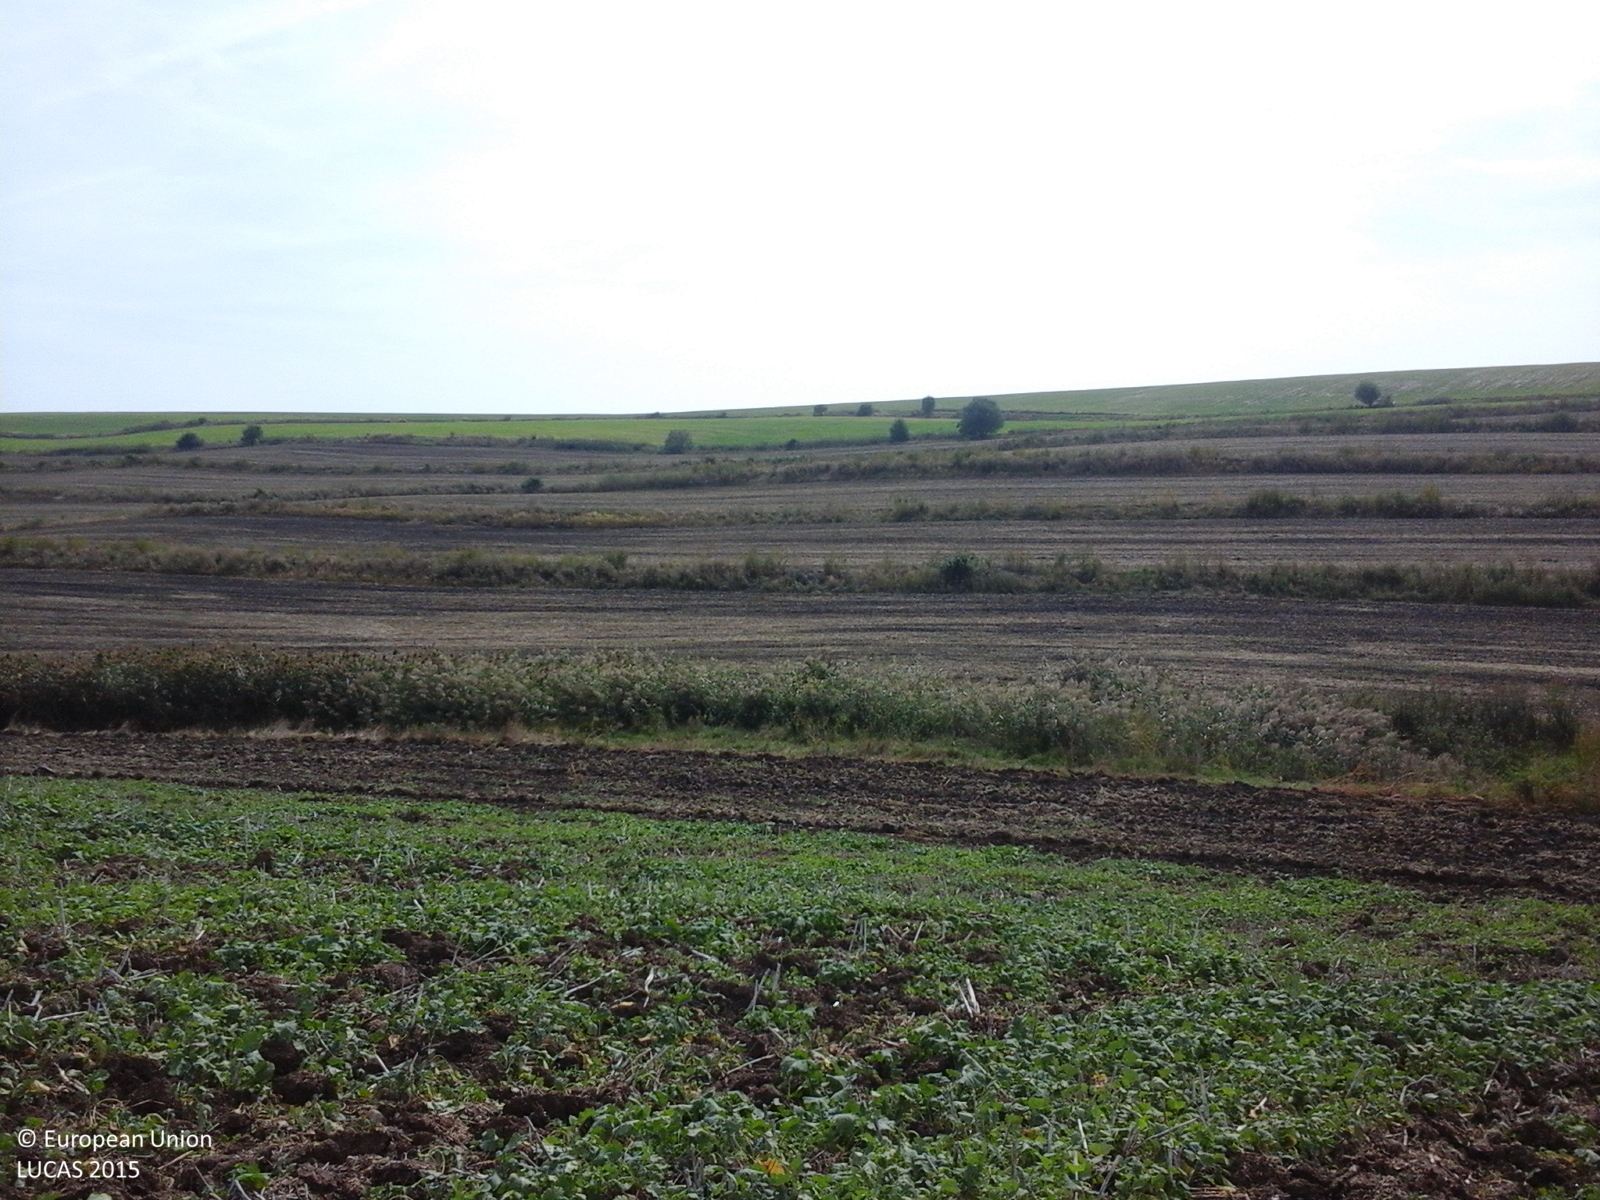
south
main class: Cropland
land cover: Rape and turnip rape
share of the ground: 25 - 50 %
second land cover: Spontaneously vegetated surfaces
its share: 50 - 75 %
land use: Agriculture (excluding fallow land and kitchen gardens)
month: September
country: RO
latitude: 46.6203
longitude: 23.7990
